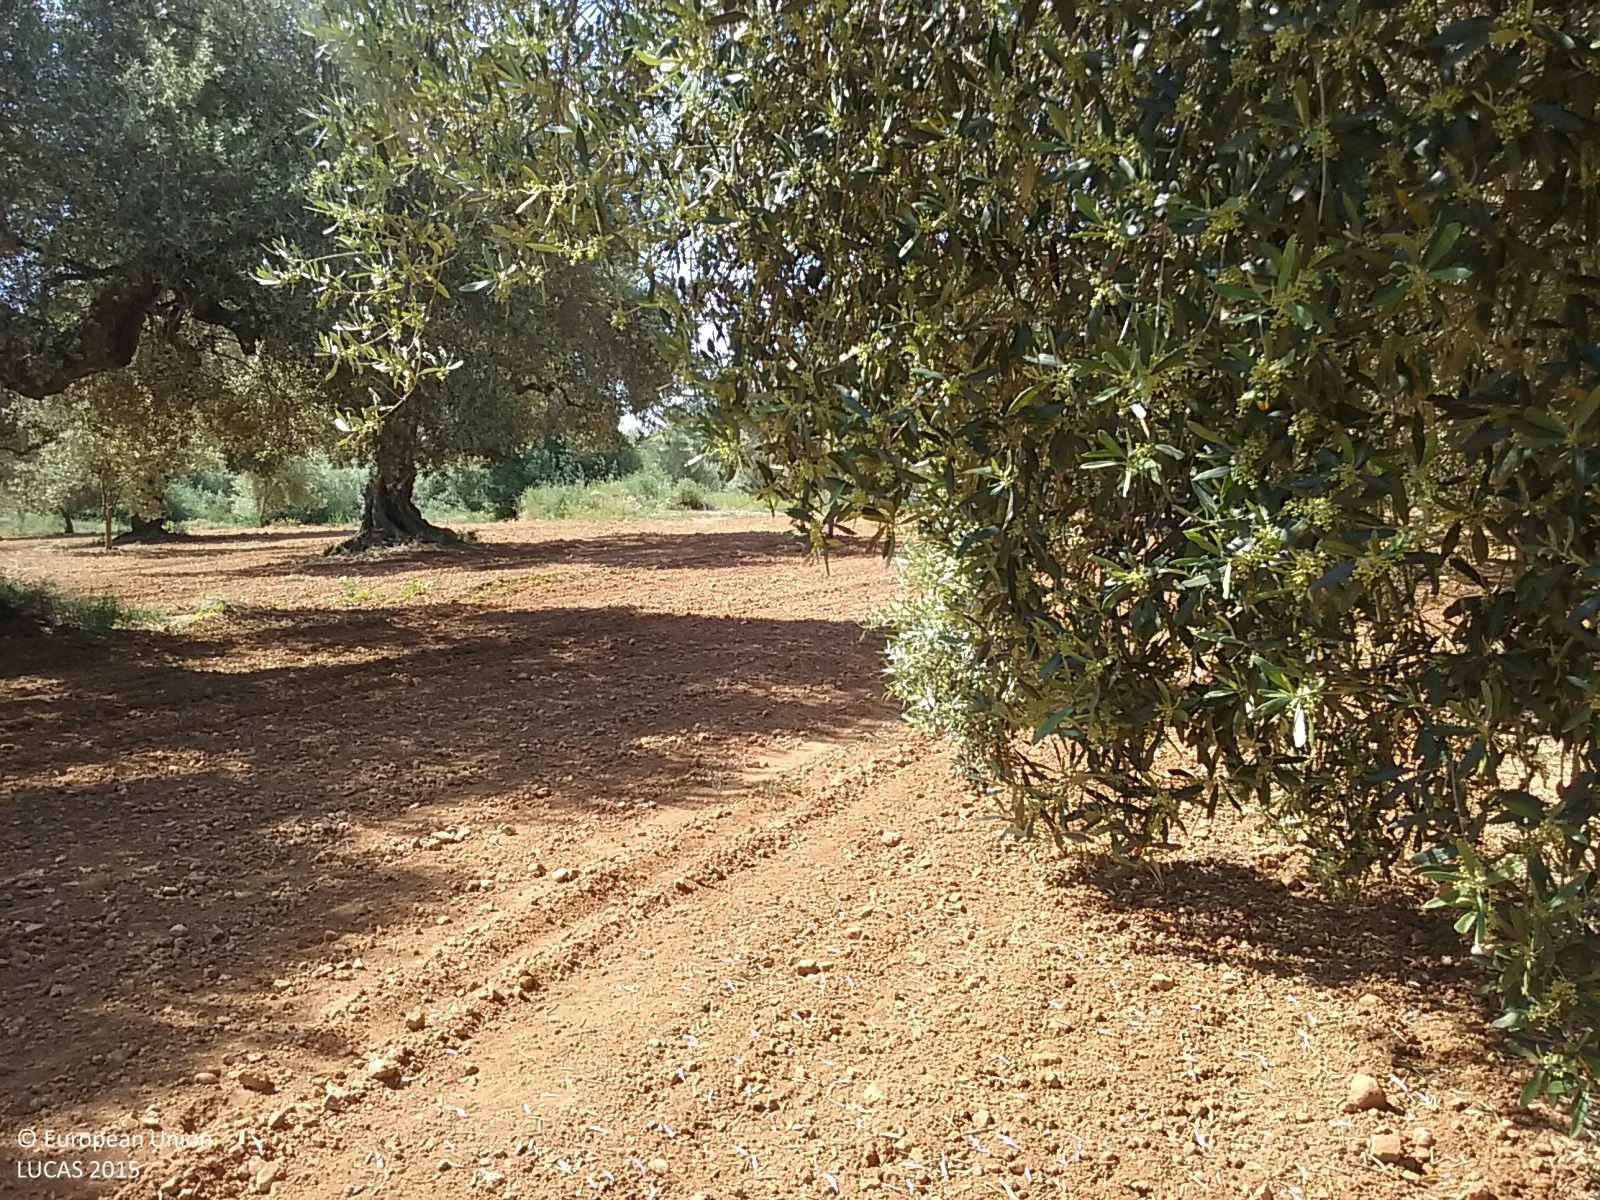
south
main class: Cropland
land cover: Olive groves
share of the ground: 50 - 75 %
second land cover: Other bare soil
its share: > 75 %
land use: Agriculture (excluding fallow land and kitchen gardens)
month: May
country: ES
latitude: 40.5504
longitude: 0.3003
